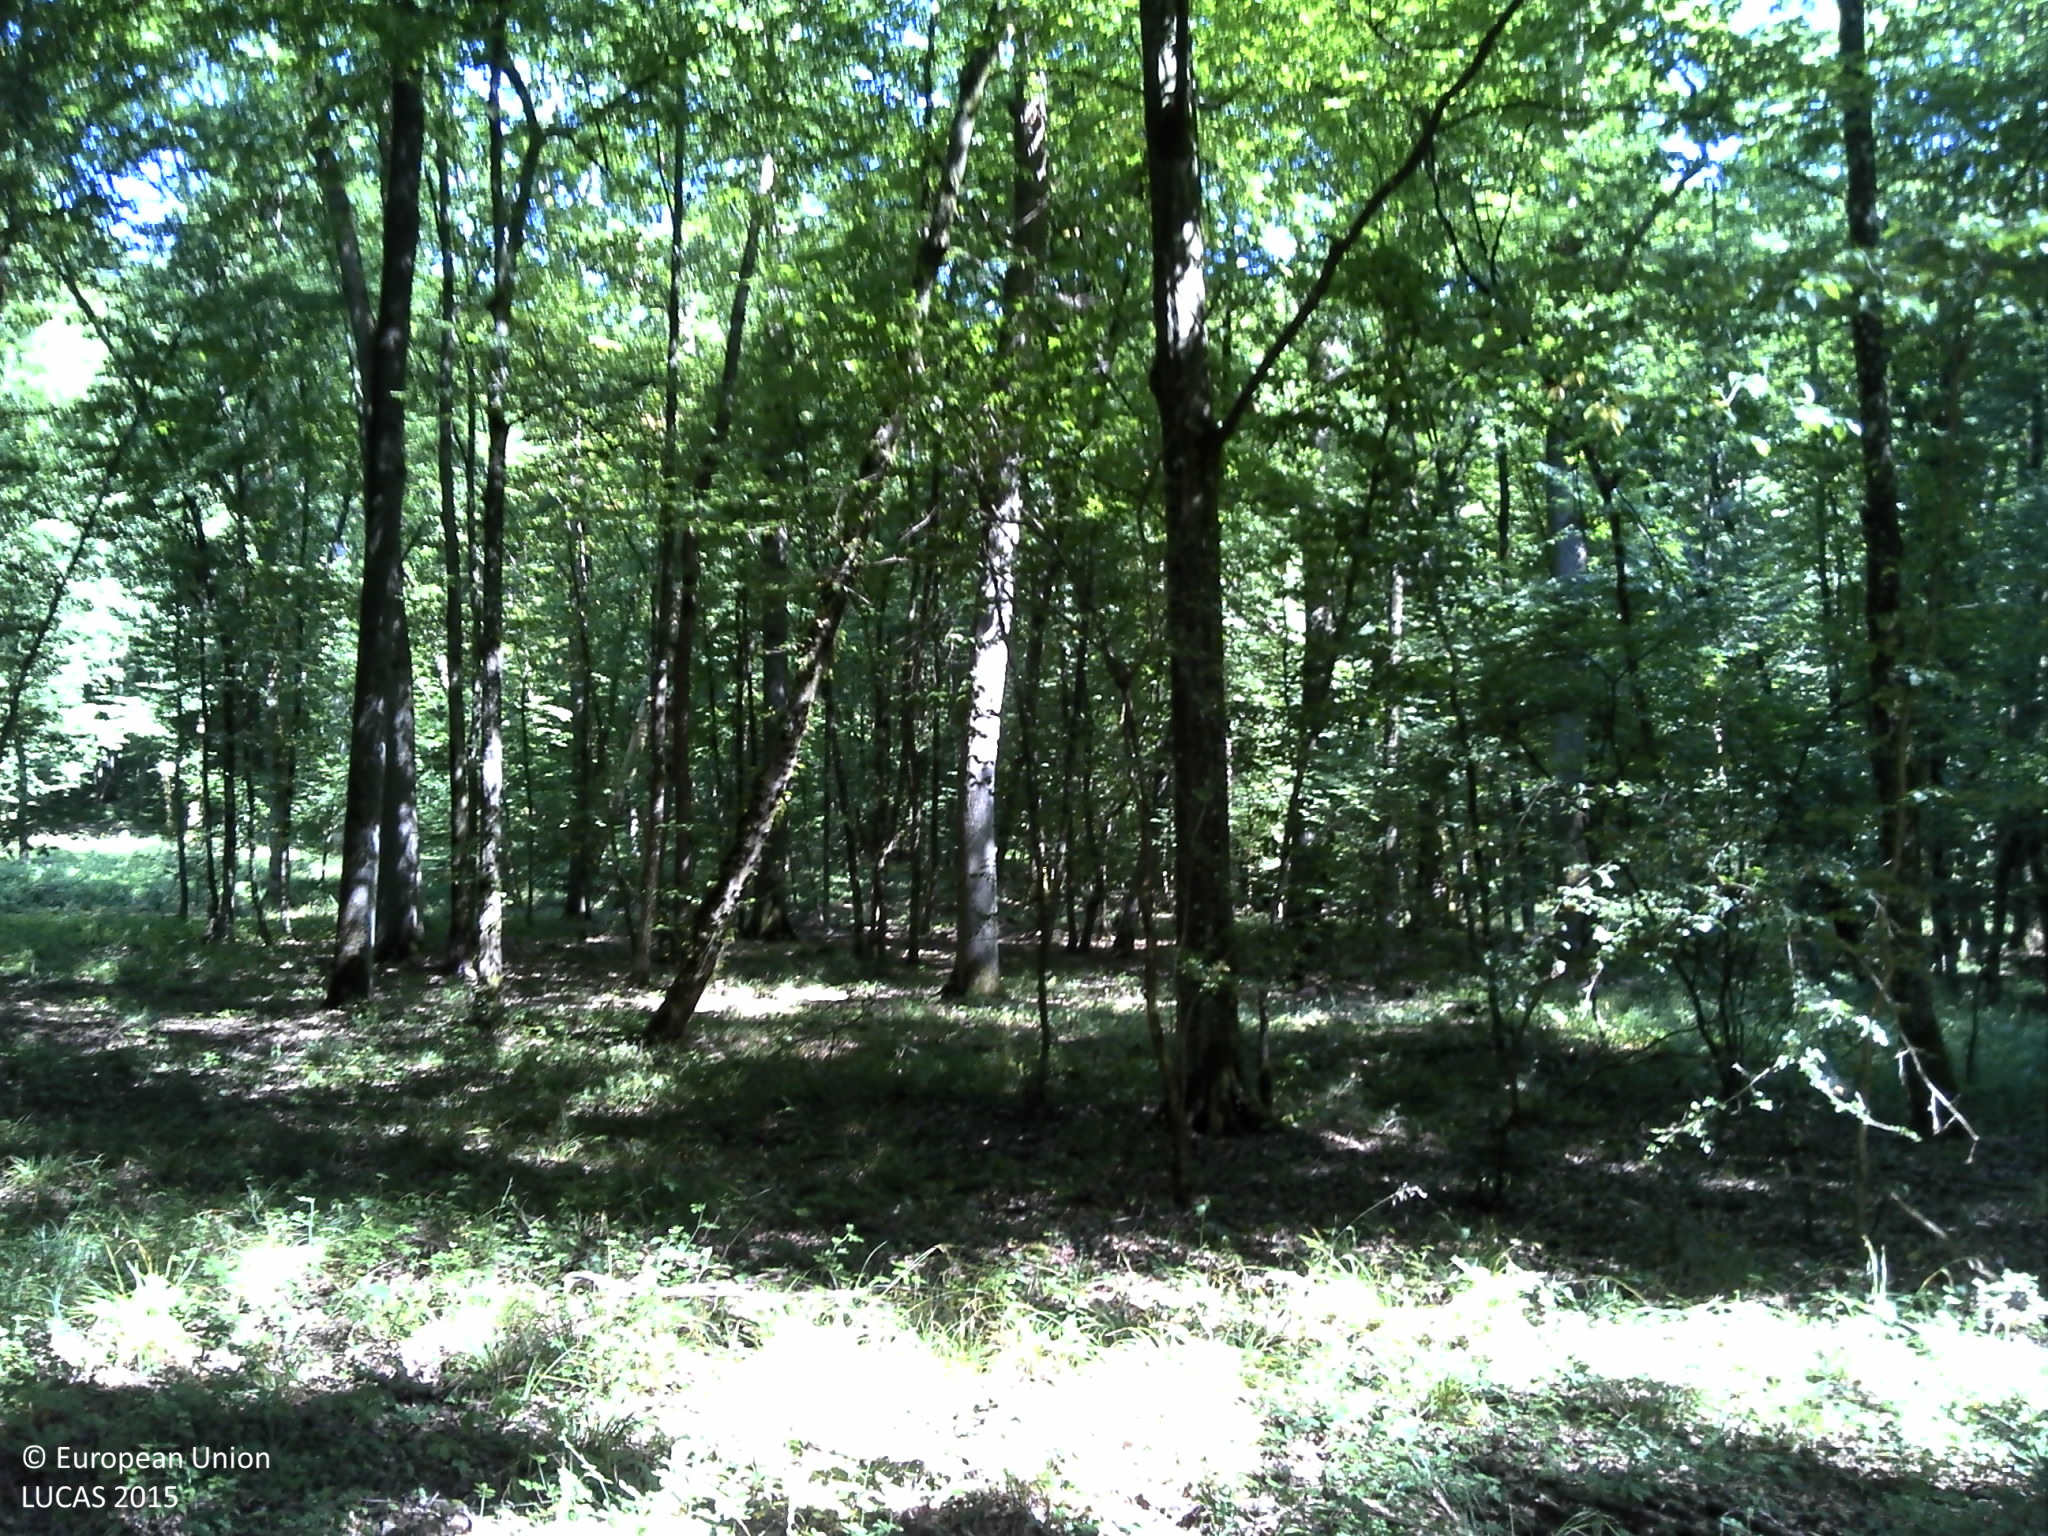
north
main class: Woodland
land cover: Broadleaved woodland
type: mesophytic deciduous forest
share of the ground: > 75 %
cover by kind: broadleaved forest trees 100 %
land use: Forestry
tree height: > 5 m
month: July
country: FR
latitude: 49.2124
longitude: 6.4995
